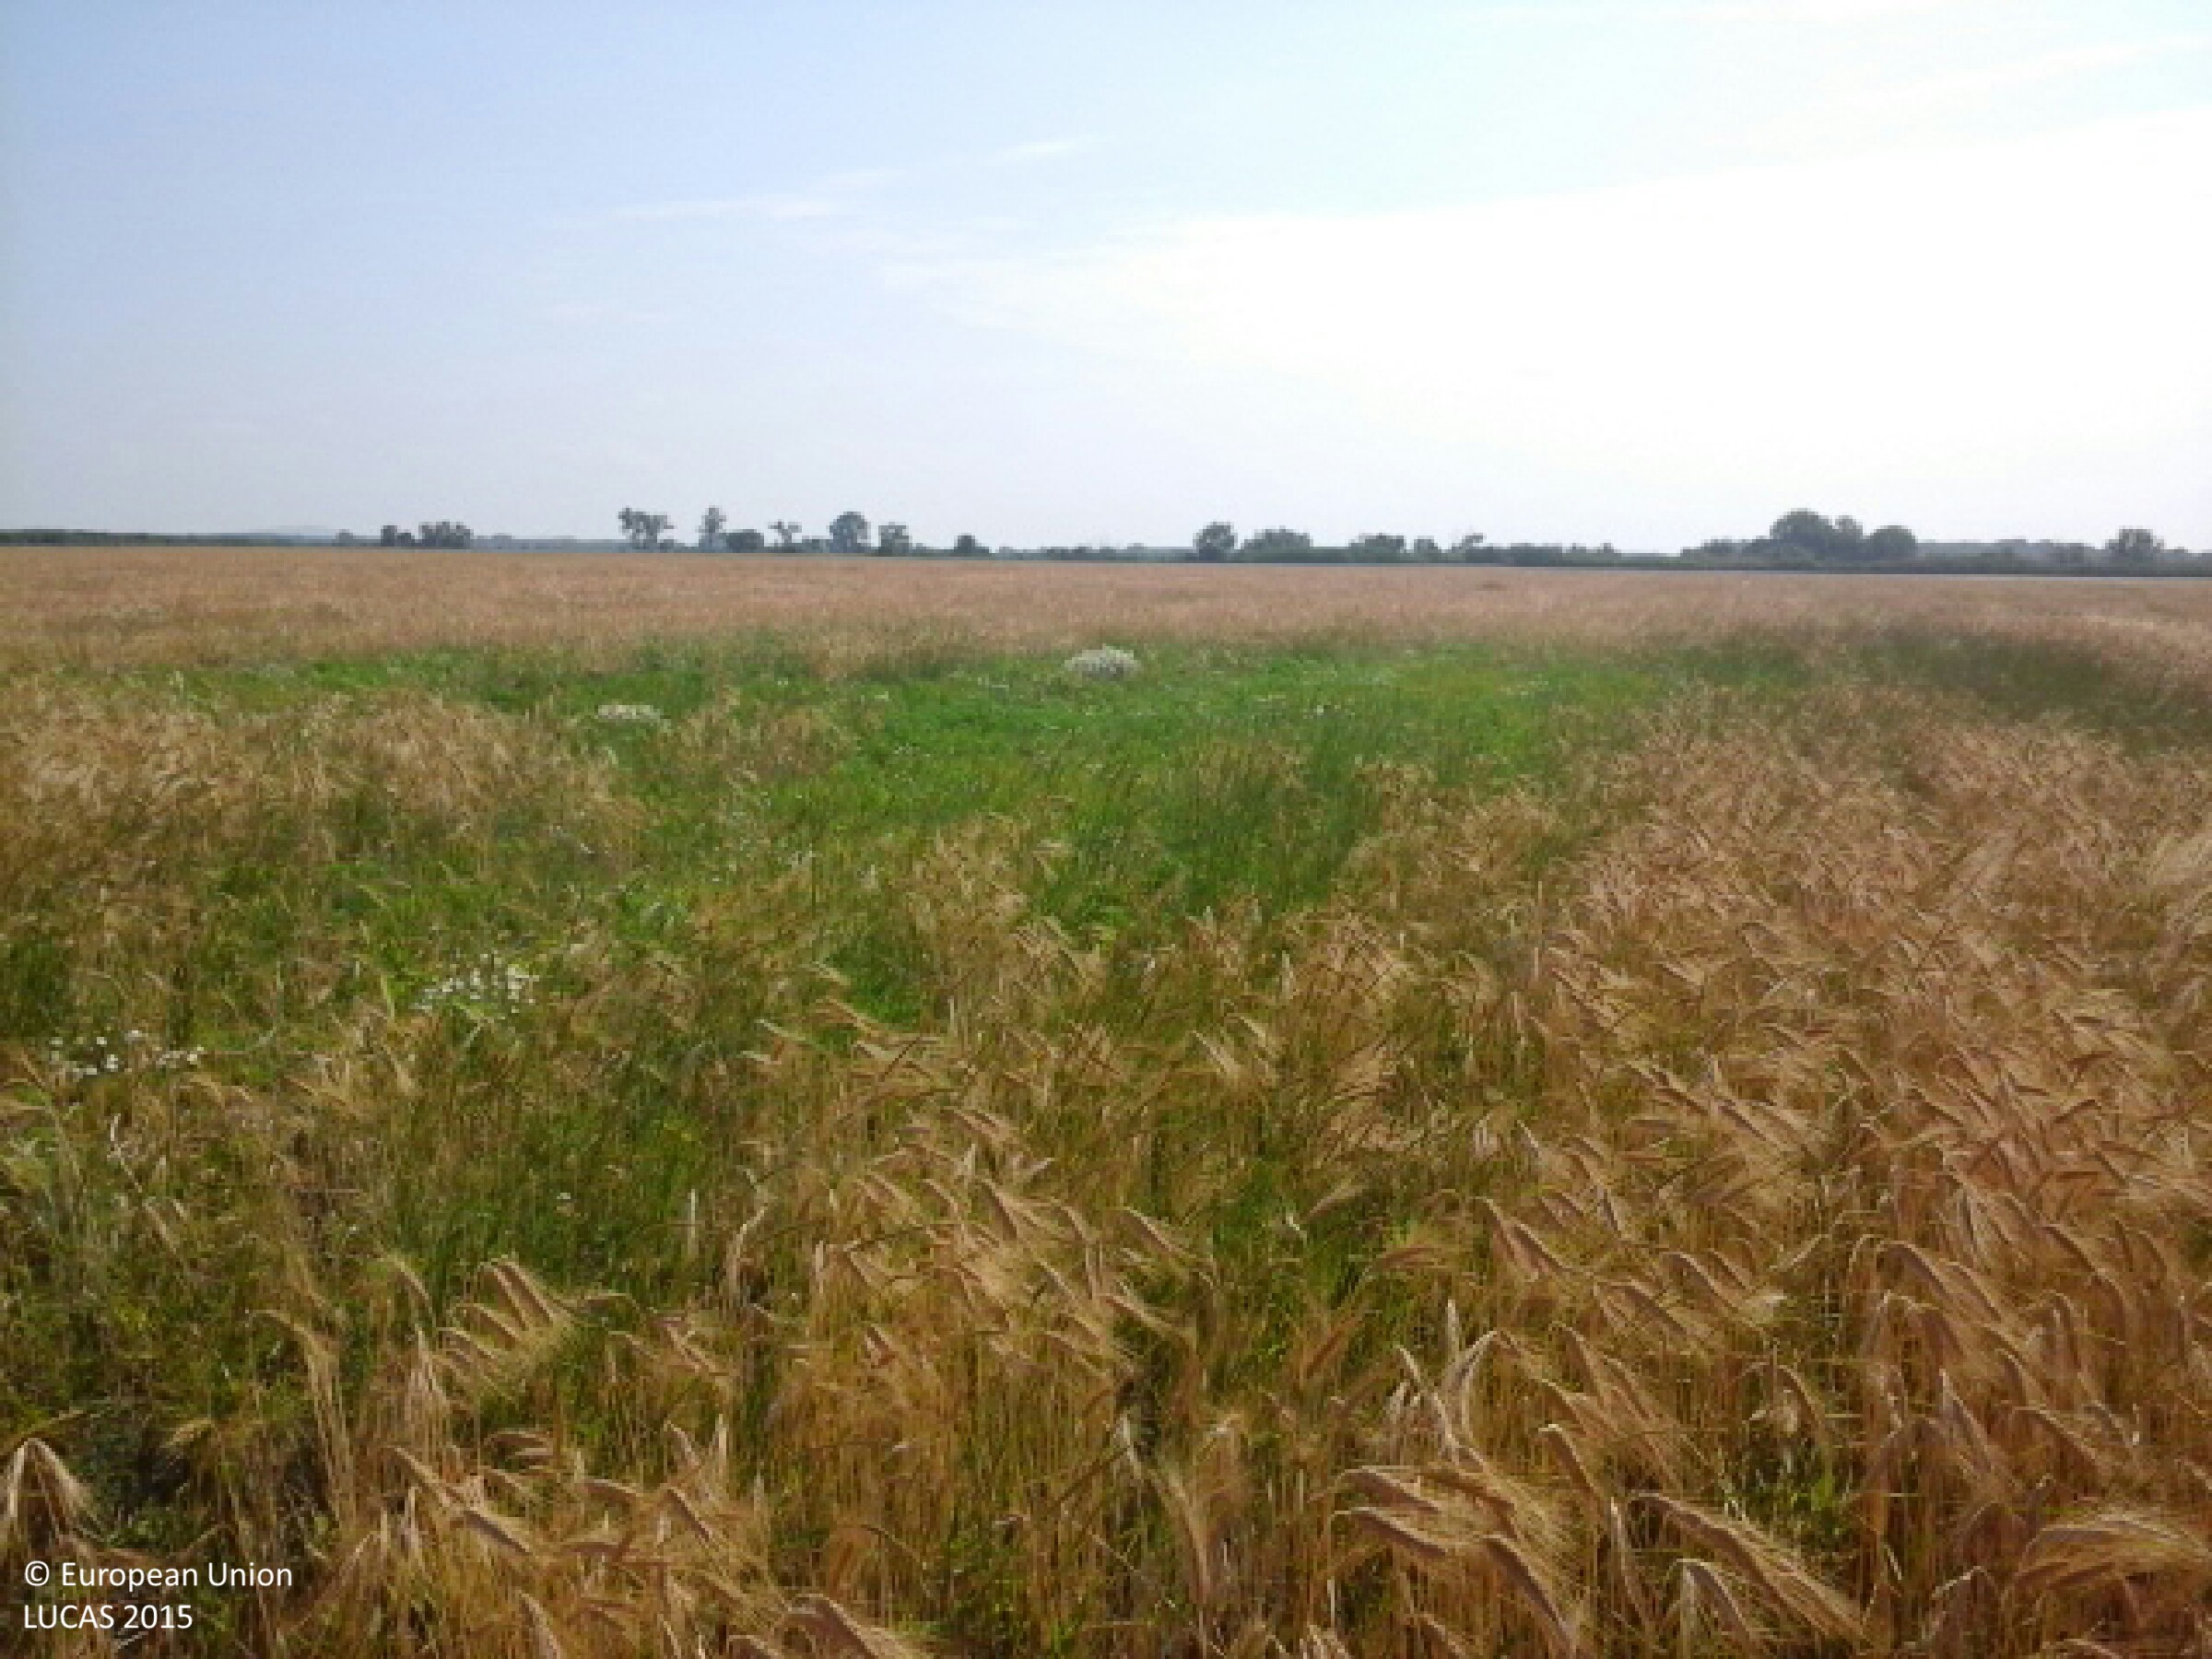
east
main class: Cropland
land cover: Barley
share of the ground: > 75 %
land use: Agriculture (excluding fallow land and kitchen gardens)
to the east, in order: Barley
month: June
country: HU
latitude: 48.3328
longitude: 21.7998
